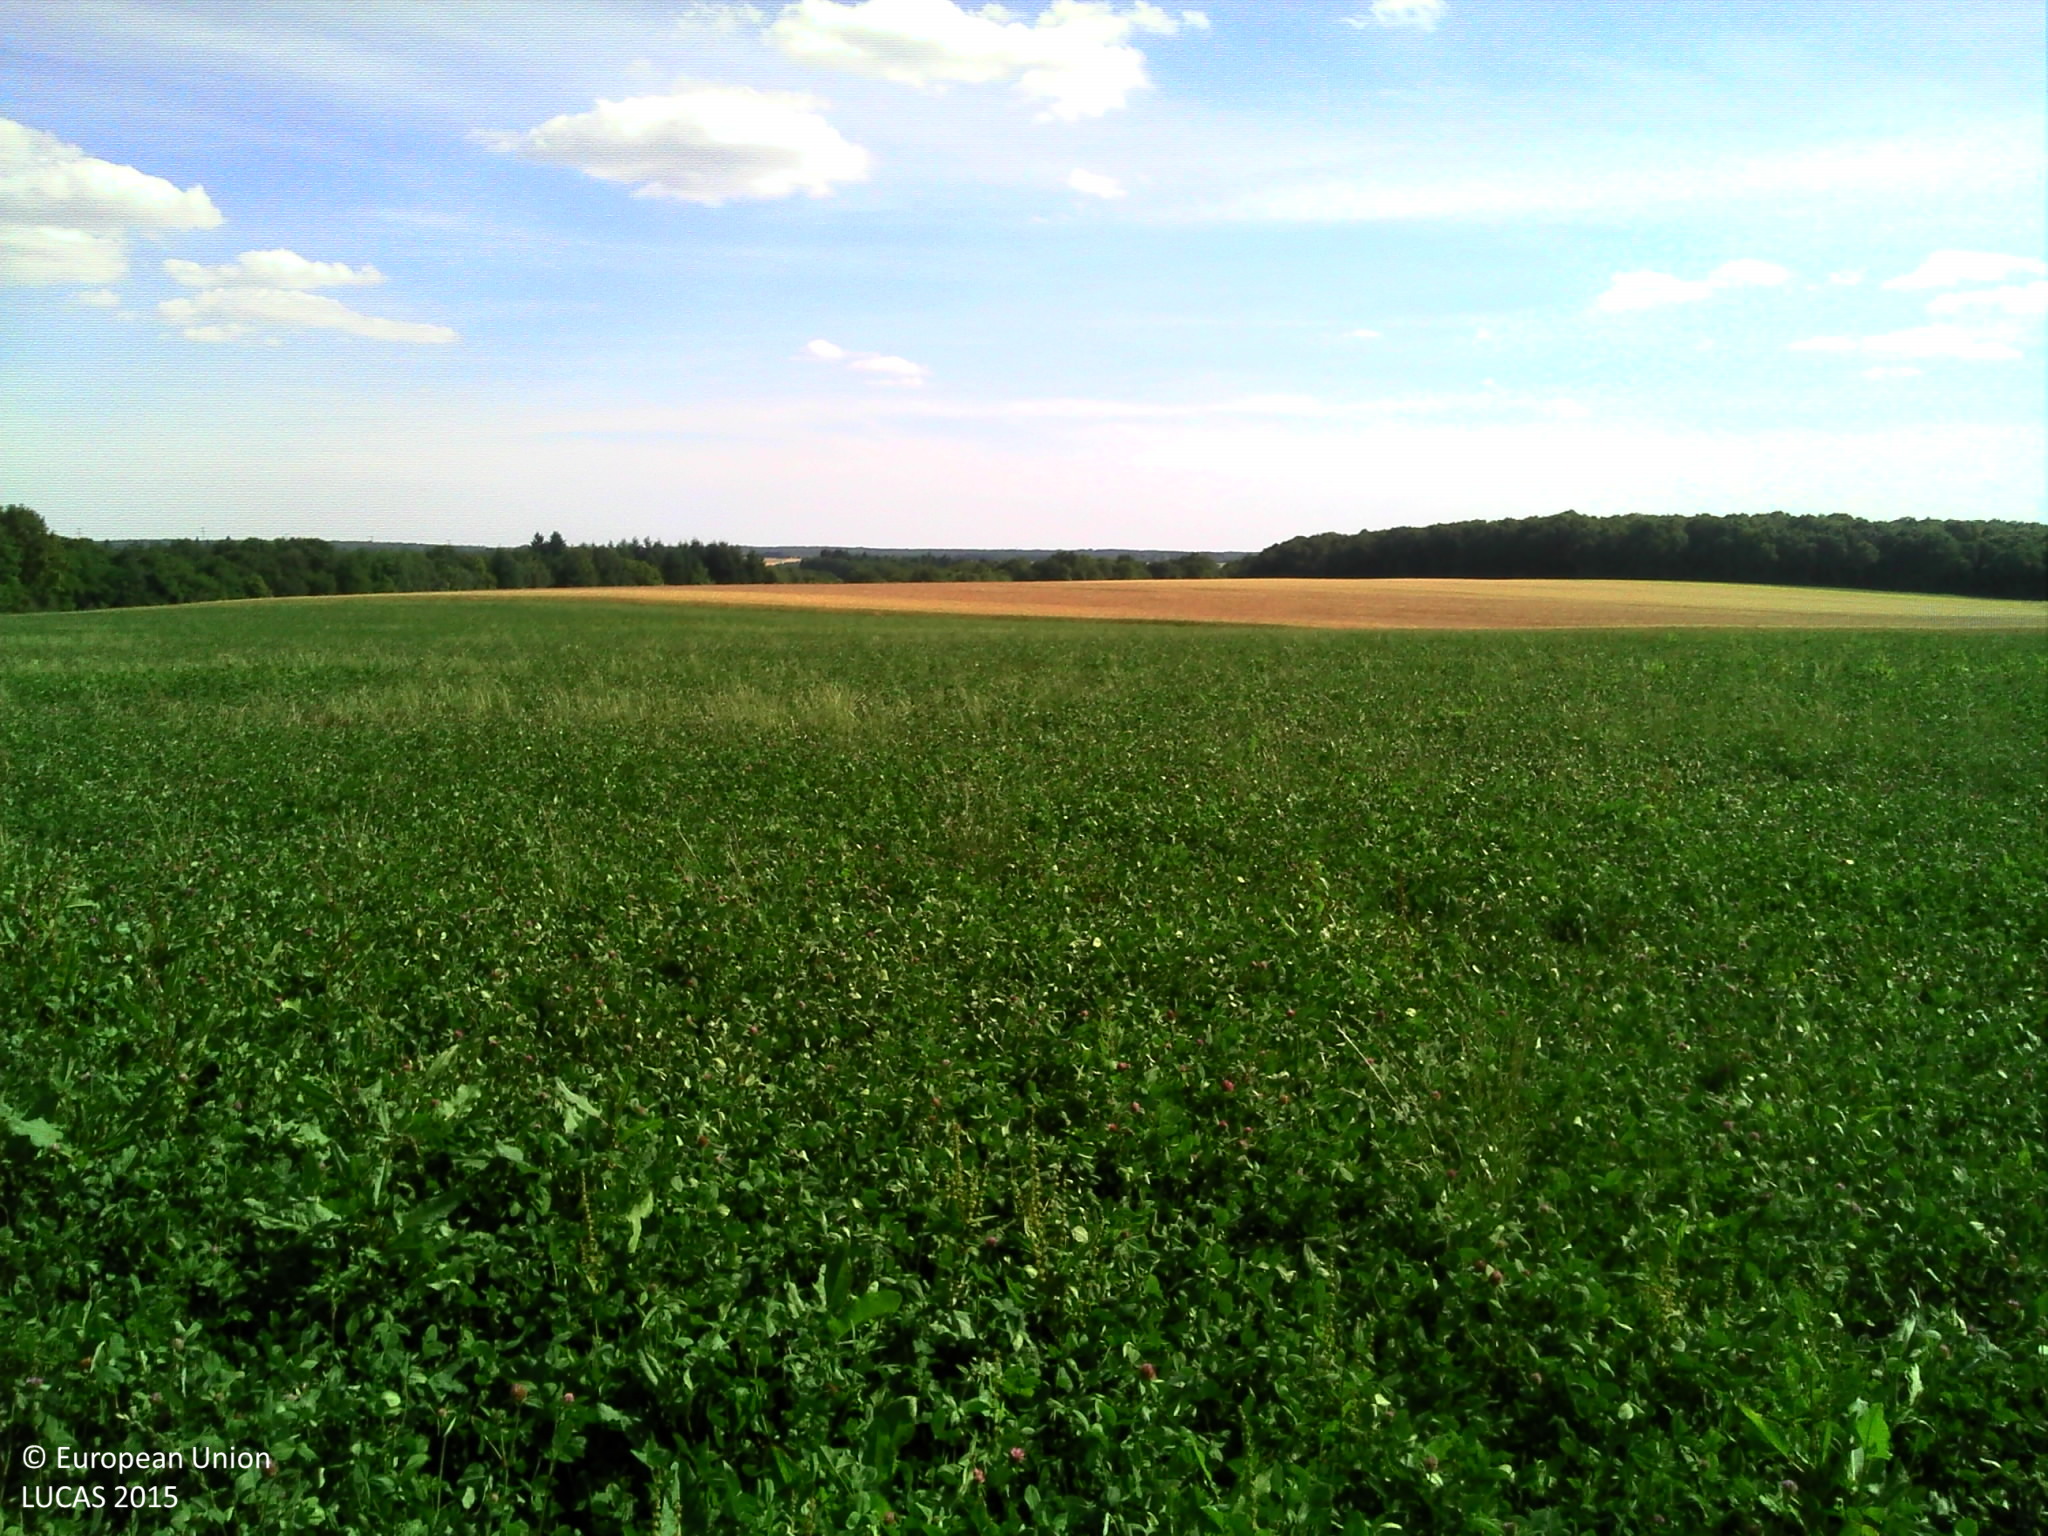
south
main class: Cropland
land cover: Clovers
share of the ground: > 75 %
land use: Agriculture (excluding fallow land and kitchen gardens)
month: June
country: FR
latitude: 48.0996
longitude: 3.4280
